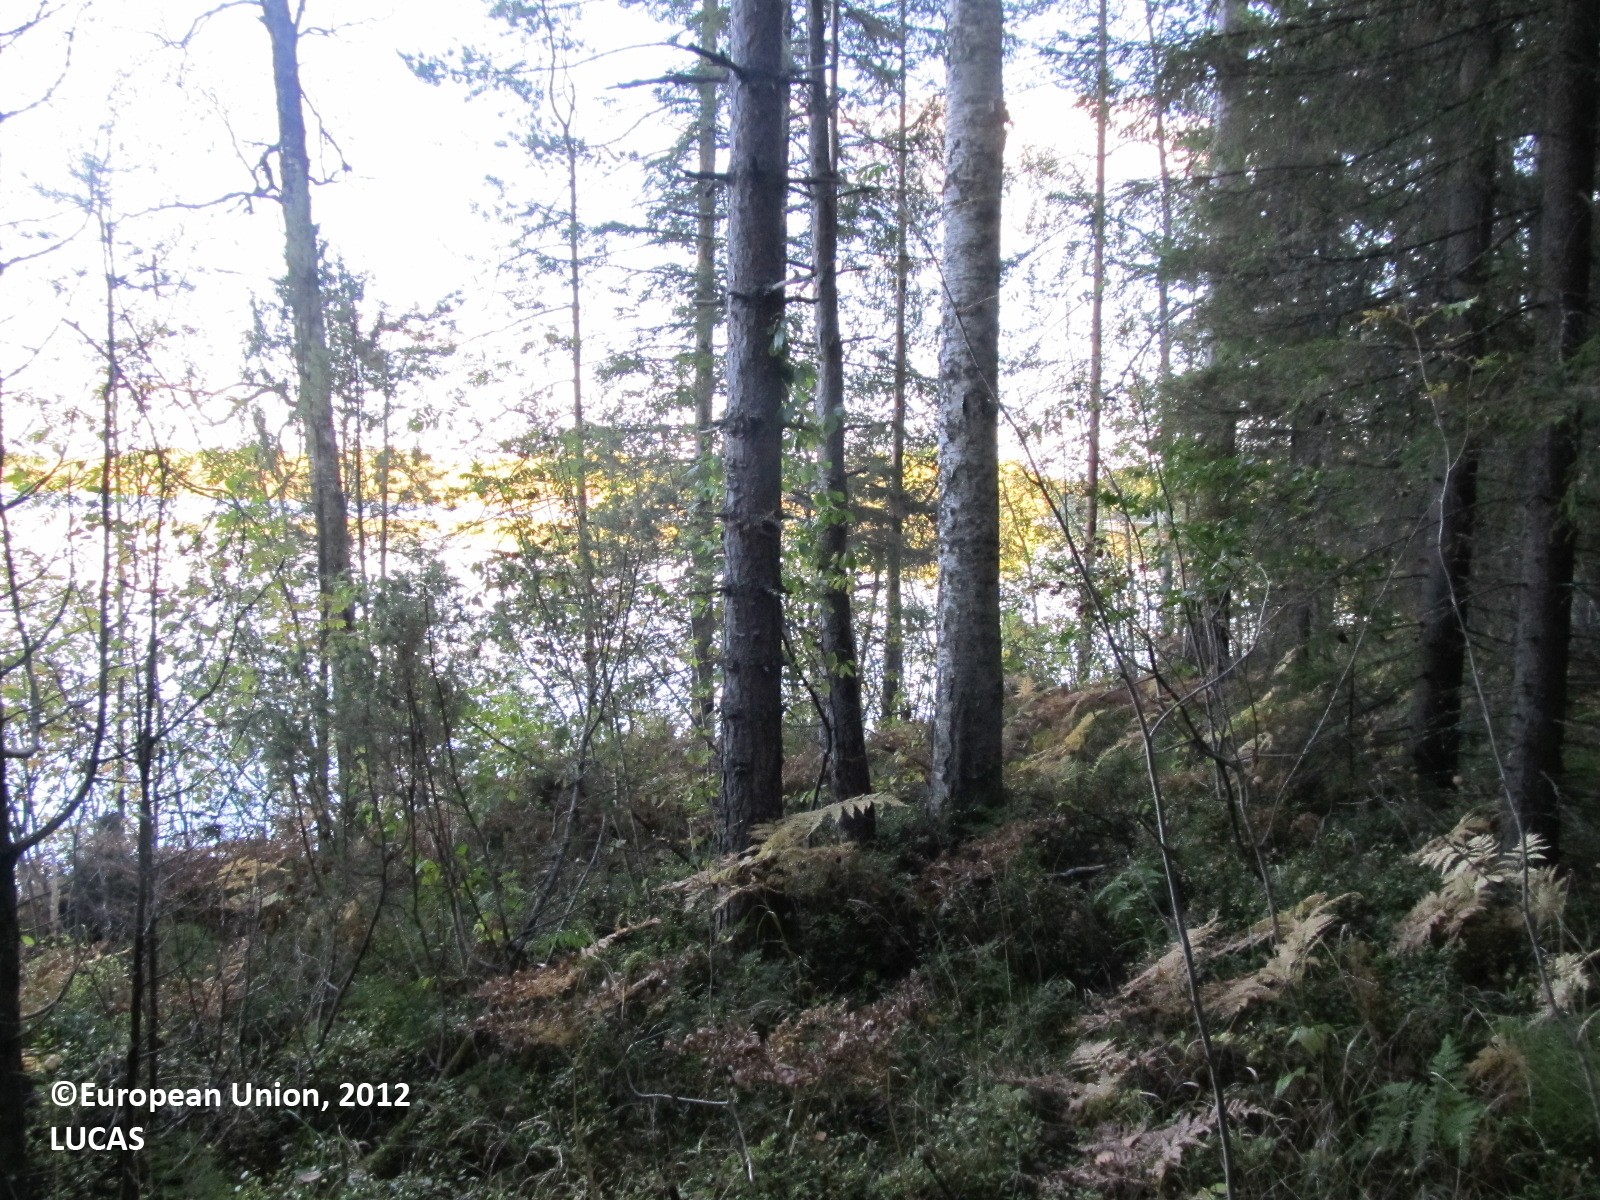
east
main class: Woodland
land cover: Spruce dominated mixed woodland
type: boreal forest
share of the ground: 25 - 50 %
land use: Forestry
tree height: > 5 m
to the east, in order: Spruce dominated mixed woodland; Inland water bodies
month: September
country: FI
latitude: 62.3739
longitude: 28.5496
